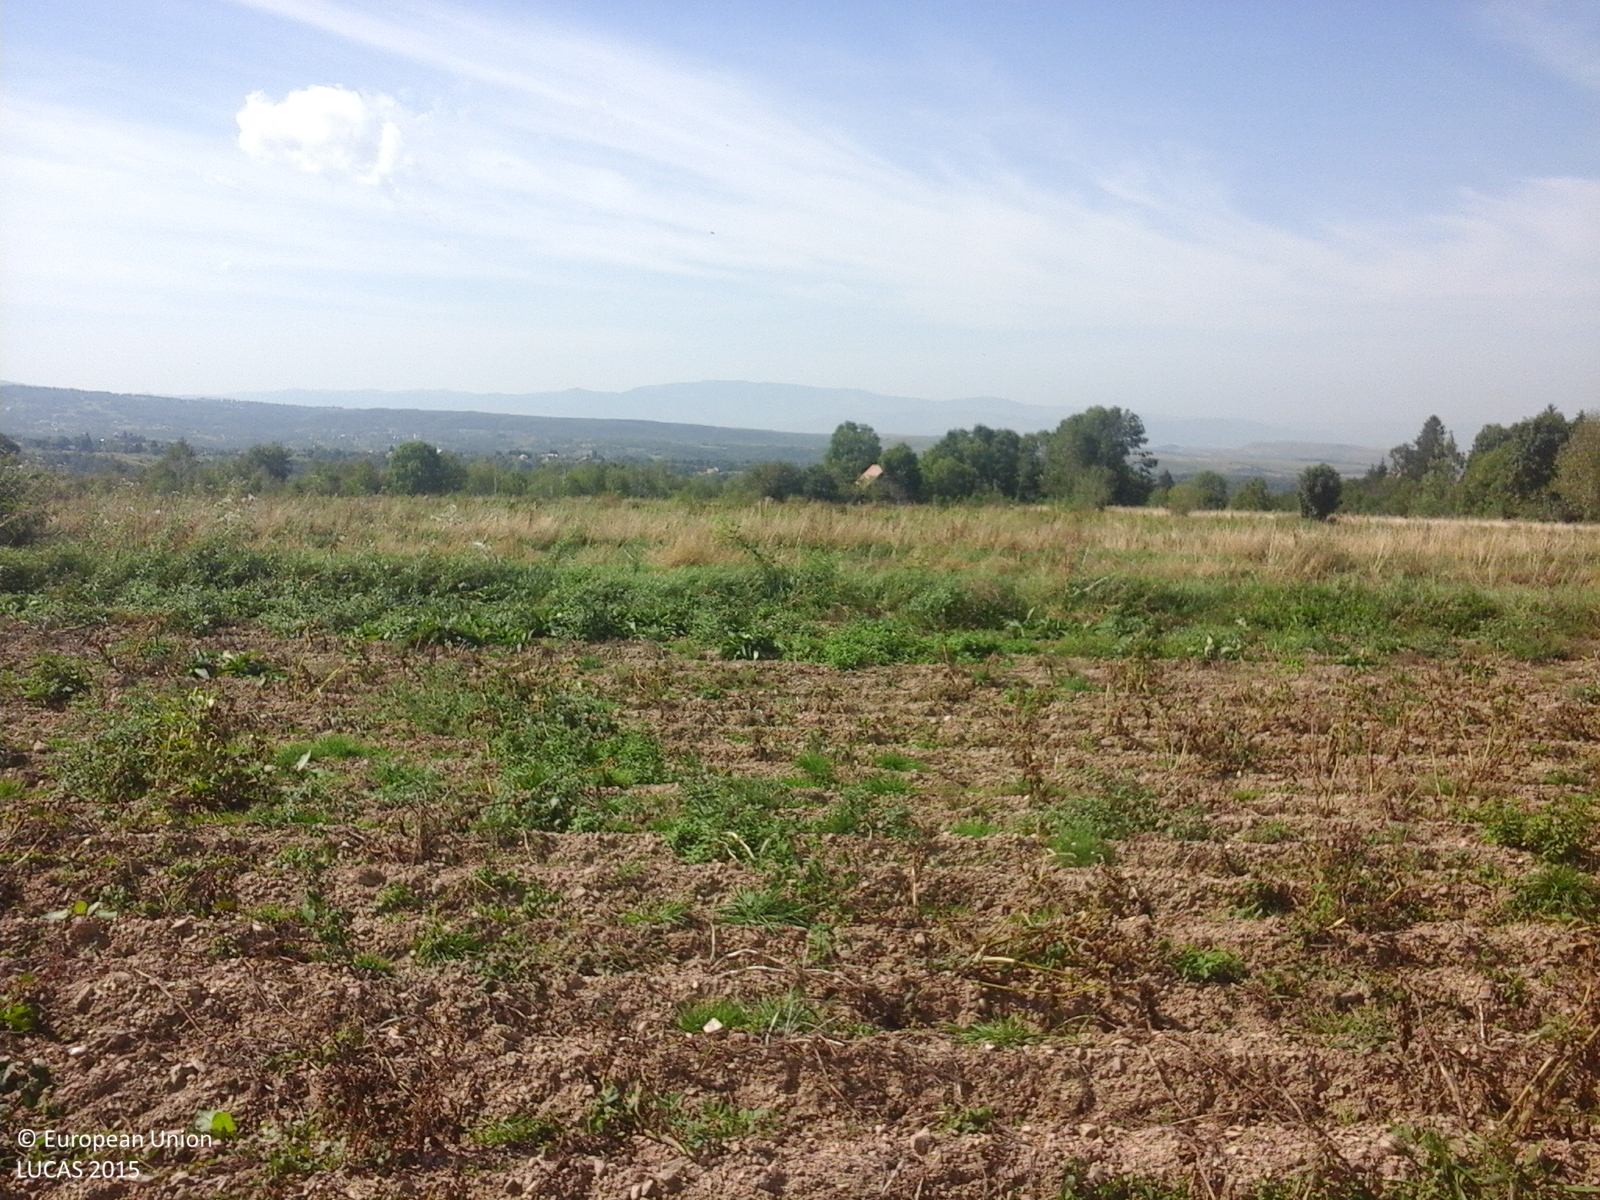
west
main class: Cropland
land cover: Potatoes
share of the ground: > 75 %
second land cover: Spontaneously vegetated surfaces
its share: 25 - 50 %
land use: Agriculture (excluding fallow land and kitchen gardens)
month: September
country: RO
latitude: 46.7516
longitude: 23.1940
